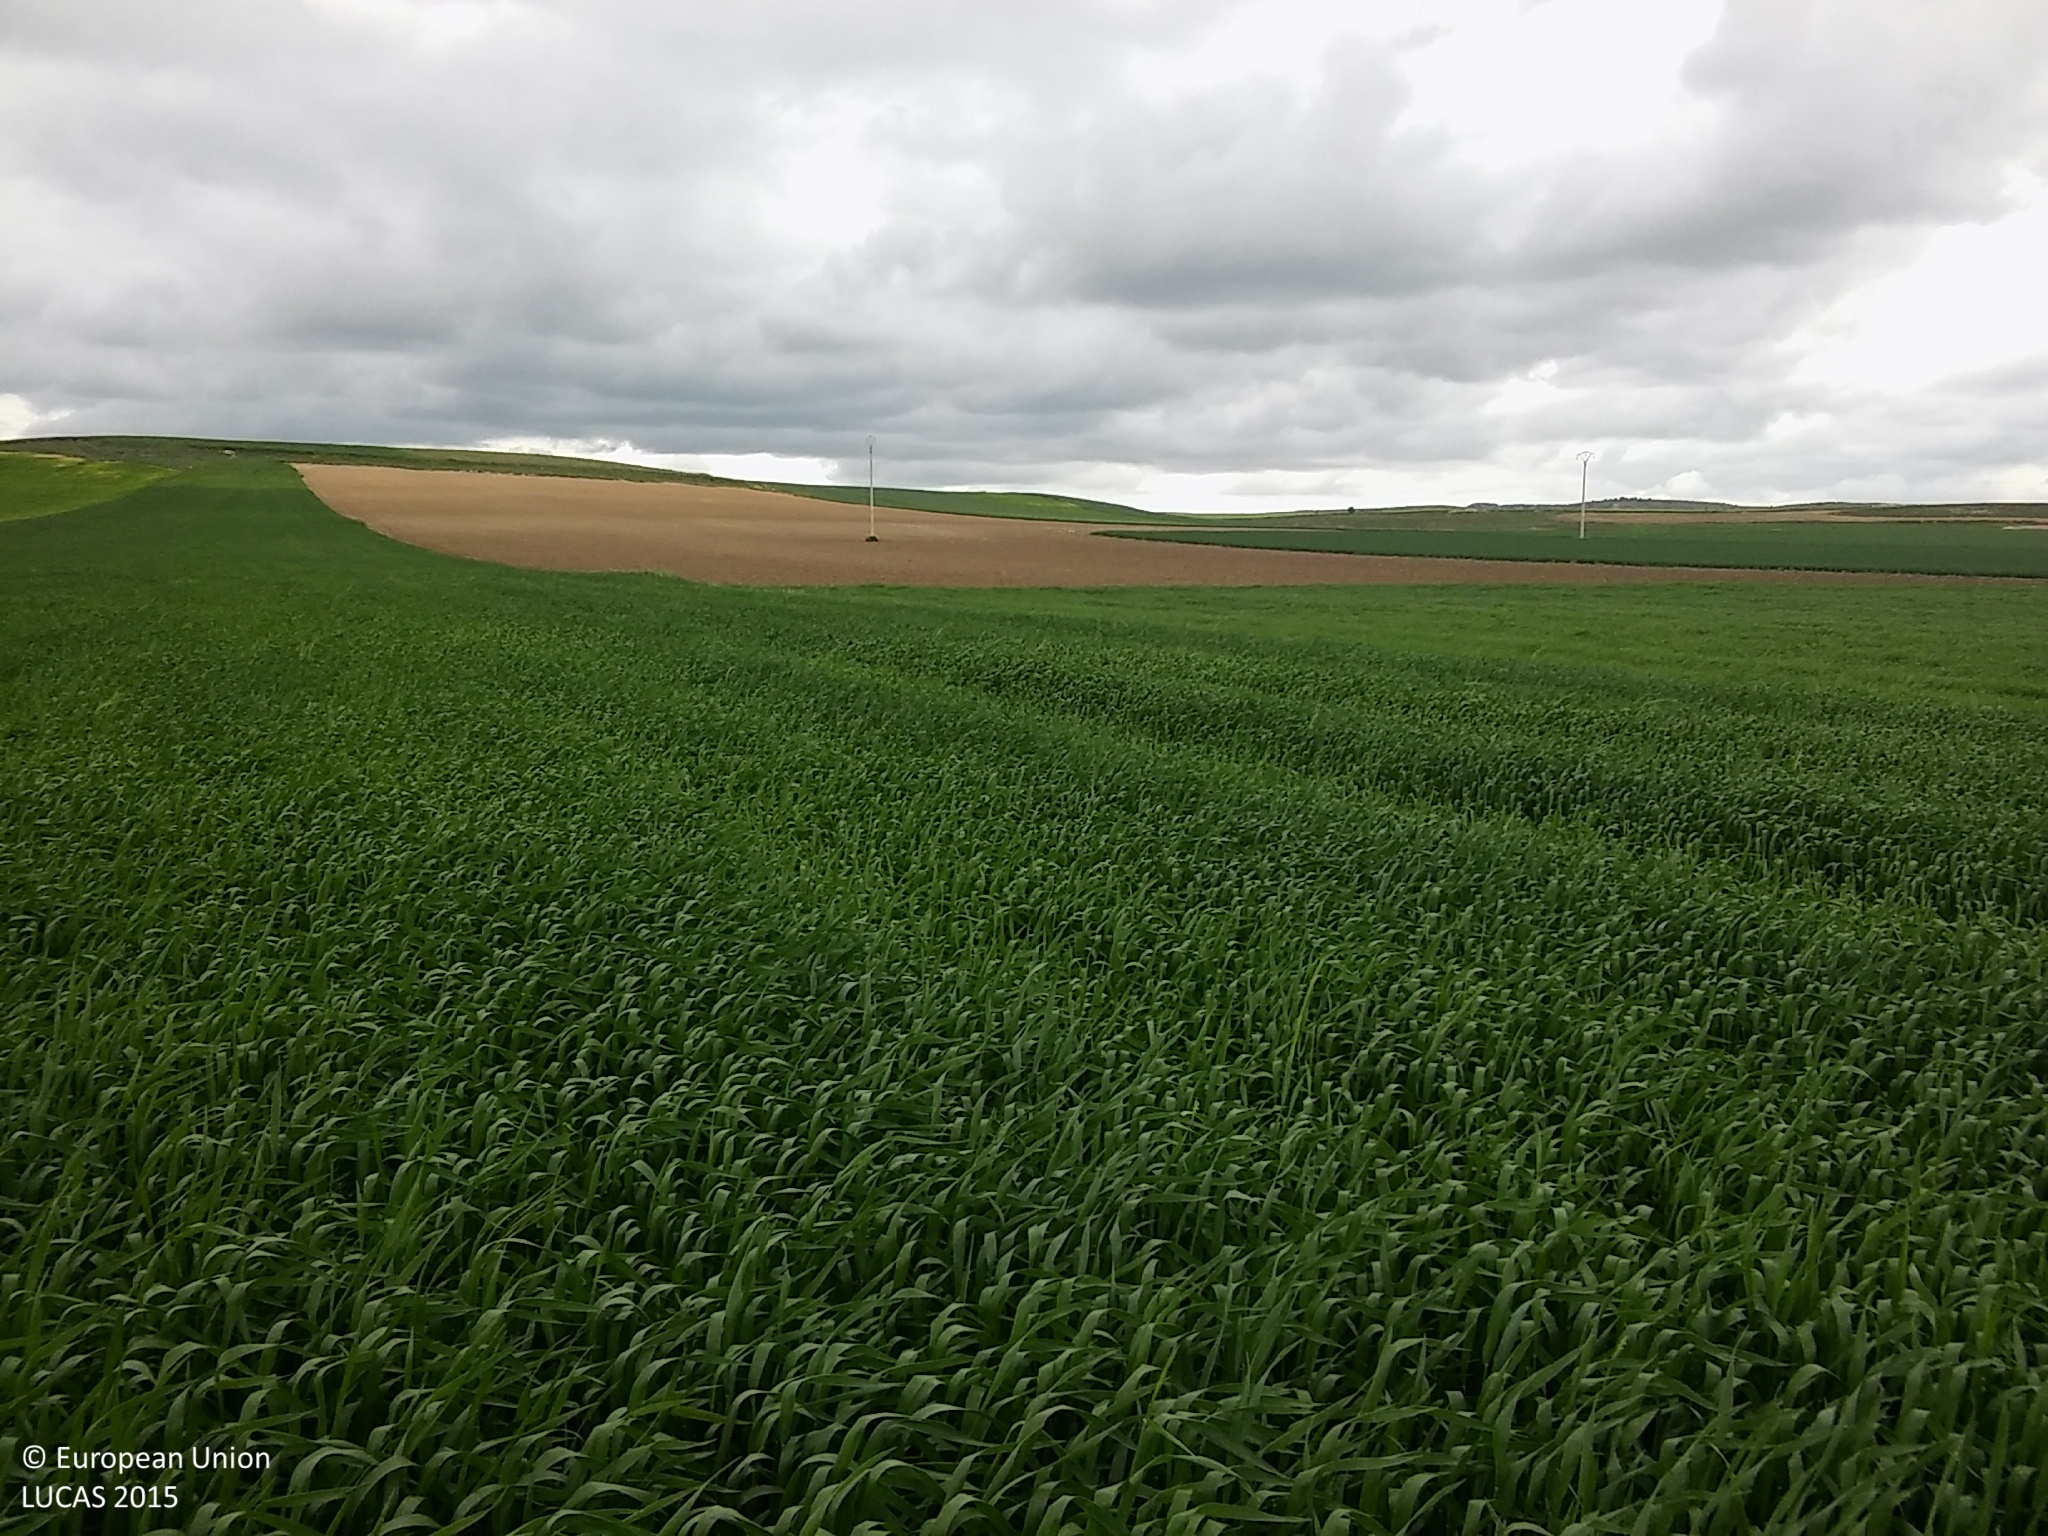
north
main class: Cropland
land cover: Barley
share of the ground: > 75 %
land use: Agriculture (excluding fallow land and kitchen gardens)
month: May
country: ES
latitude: 41.3888
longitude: -3.9618
